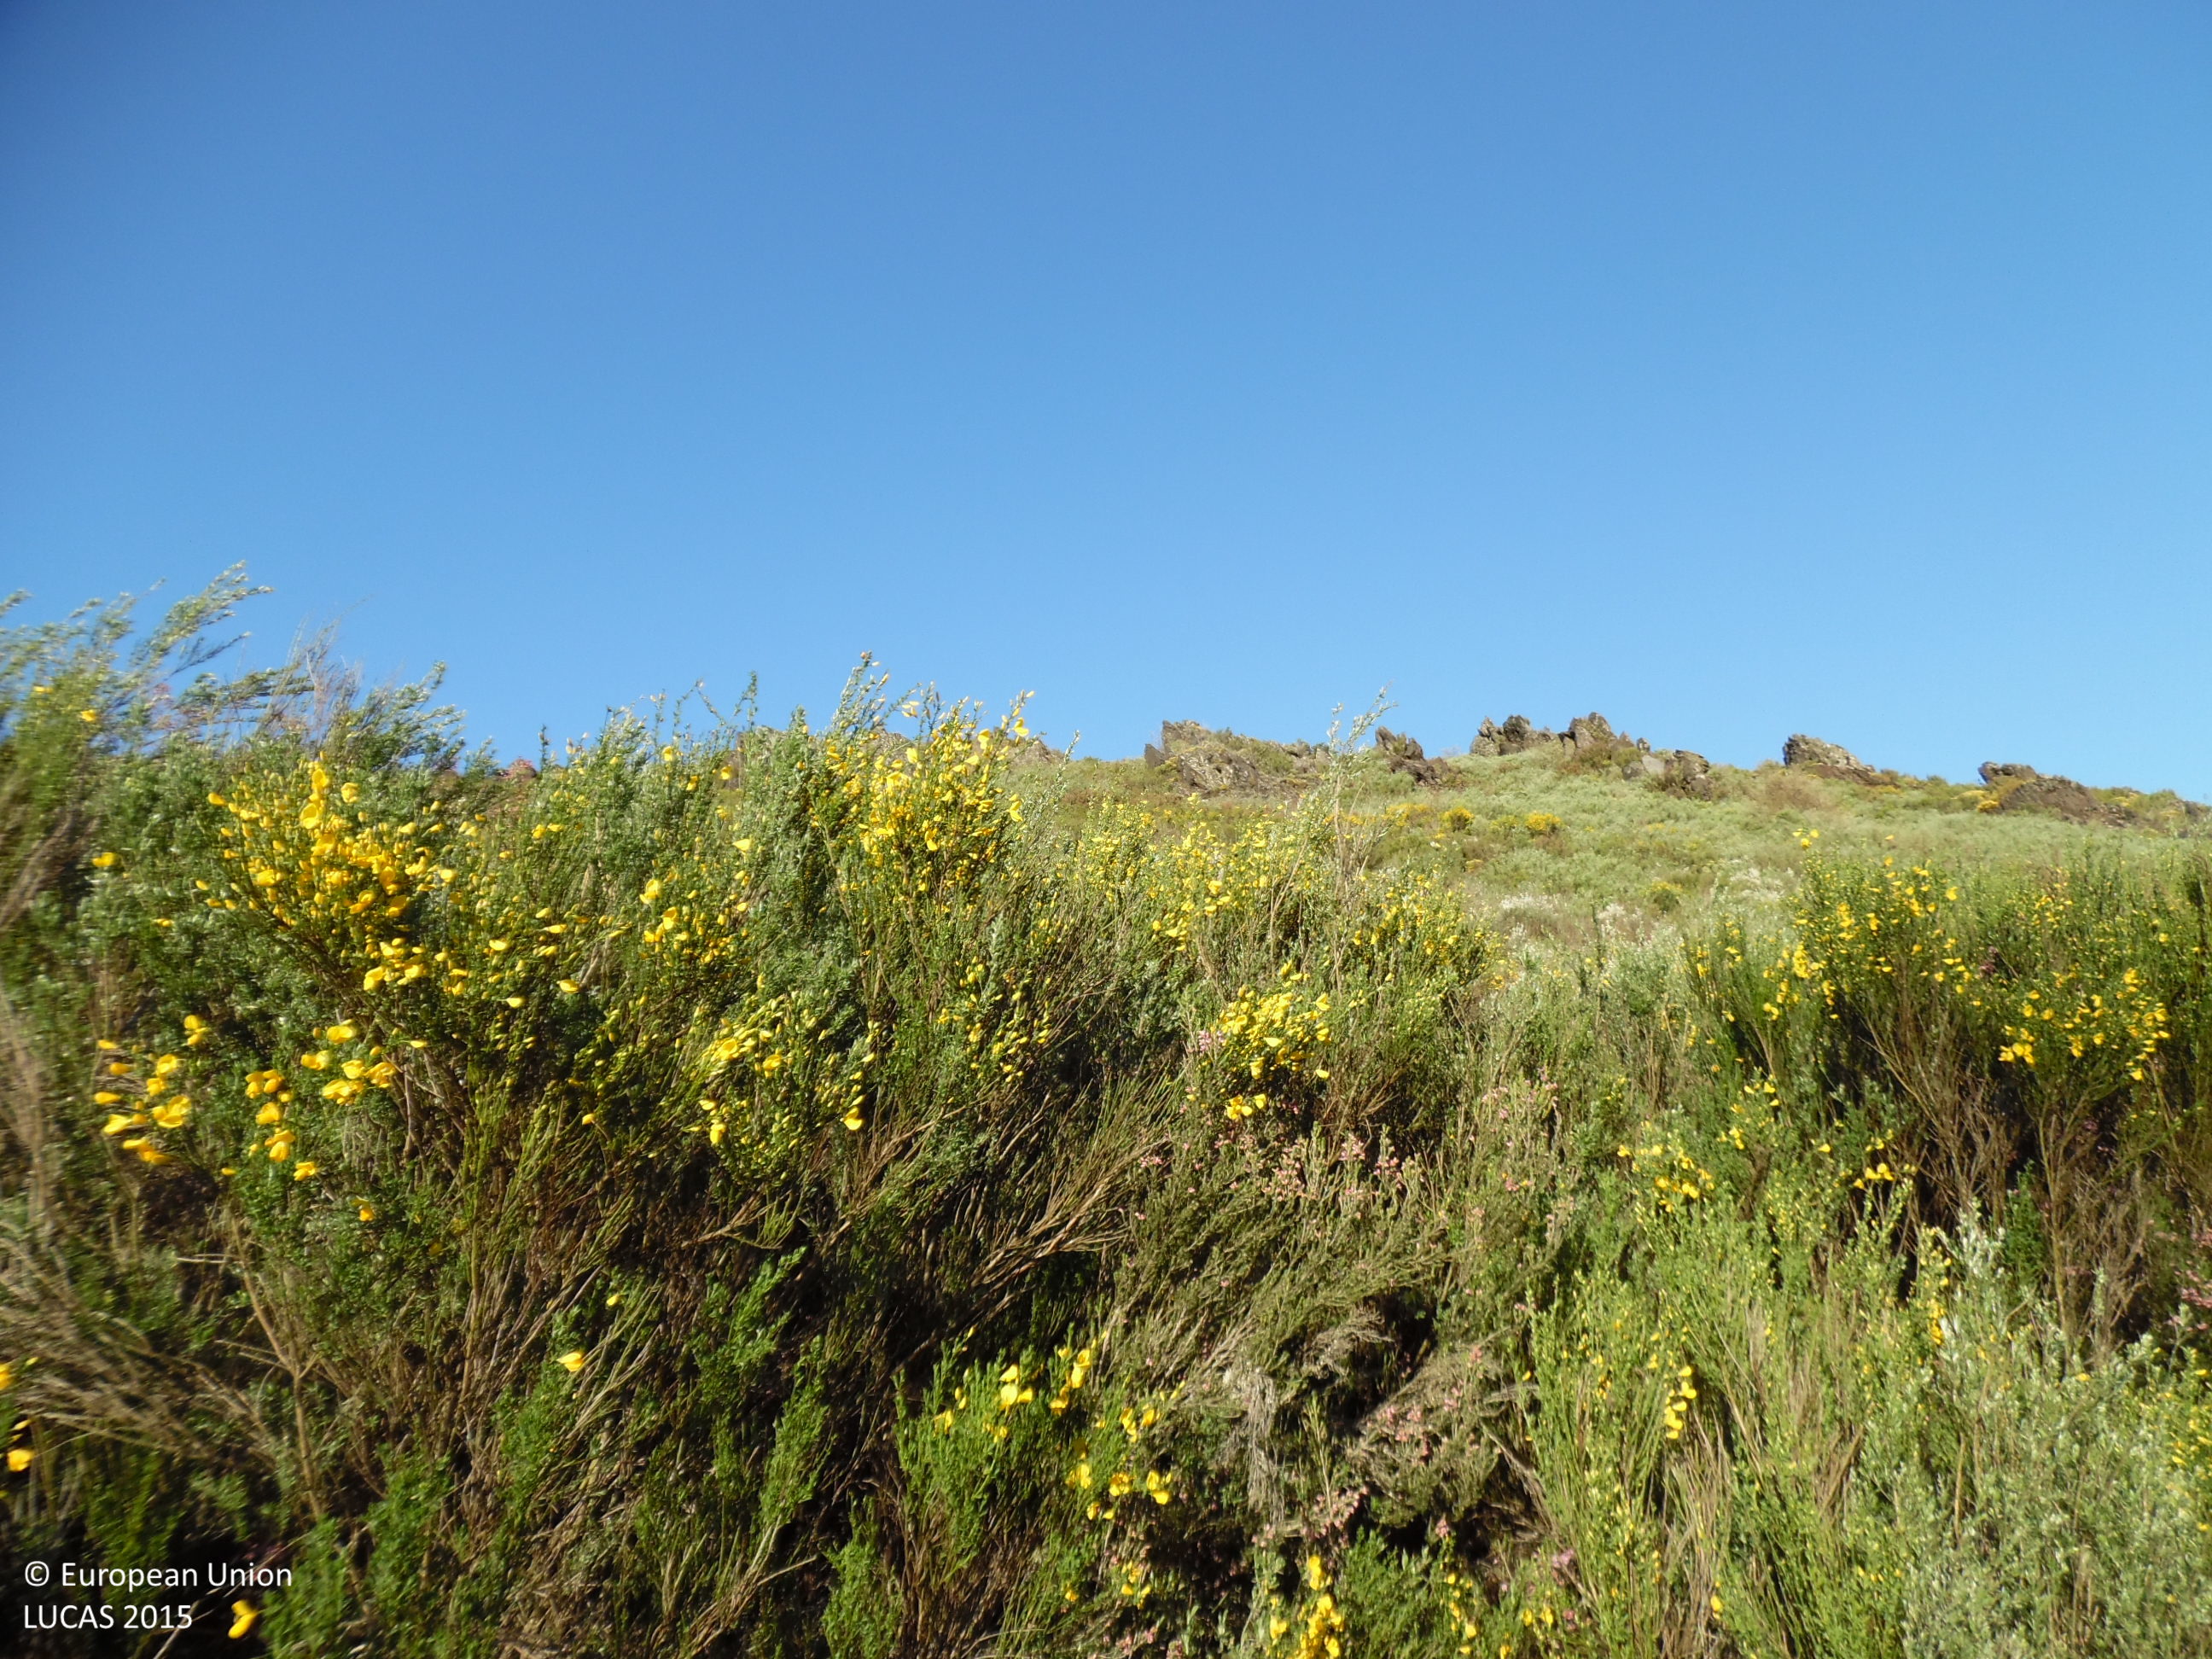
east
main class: Shrubland
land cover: Shrubland without tree cover
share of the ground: > 75 %
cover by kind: shrubs 100 %
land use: Semi-natural and natural areas not in use
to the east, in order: Shrubland without tree cover; Rocks and stones; Shrubland without tree cover; Rock outcrops; Shrubland without tree cover; Shrubland with sparse tree cover; Tracks; Other bare soil; Shrubland without tree cover
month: May
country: ES
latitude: 42.6779
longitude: -6.1082
